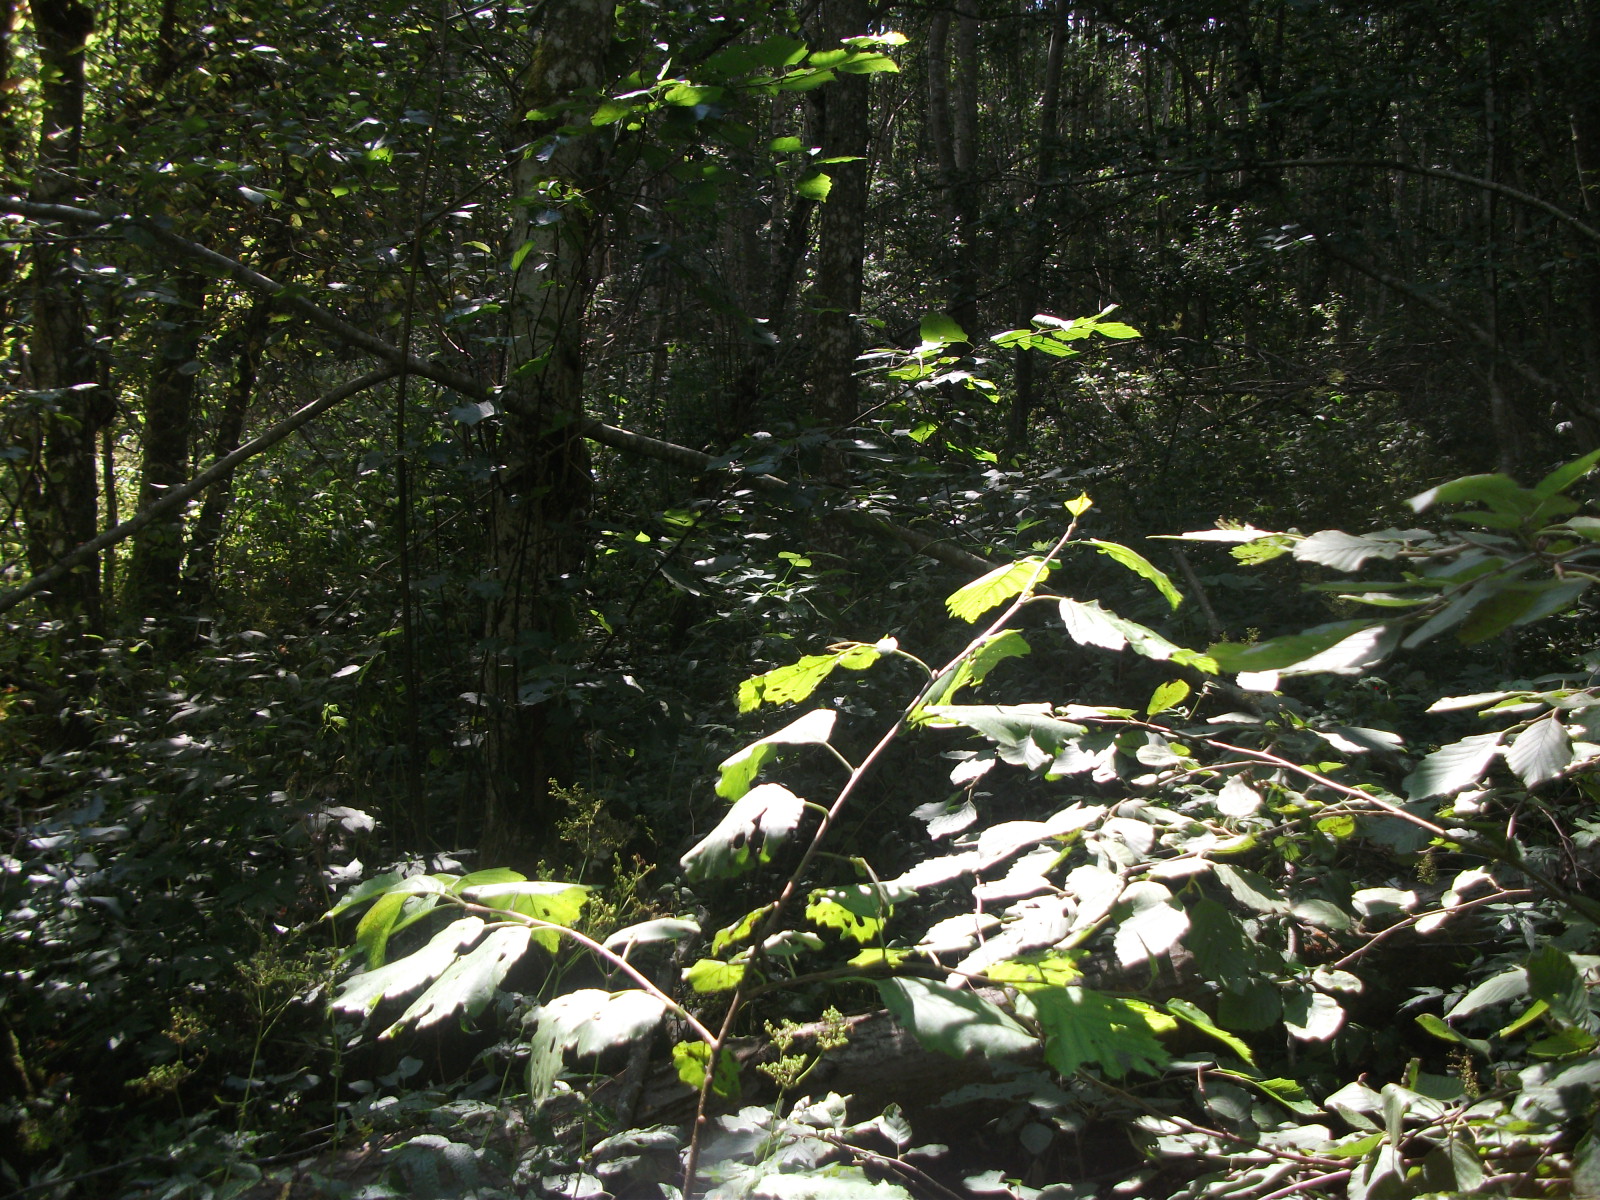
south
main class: Woodland
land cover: Broadleaved woodland
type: non-riverine alder, birch or aspen forest
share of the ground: > 75 %
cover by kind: broadleaved forest trees 80 %, shrubs 10 %, herbaceous plants 10 %
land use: Forestry
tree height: < 5 m
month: August
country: LV
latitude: 56.8778
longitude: 26.3368
